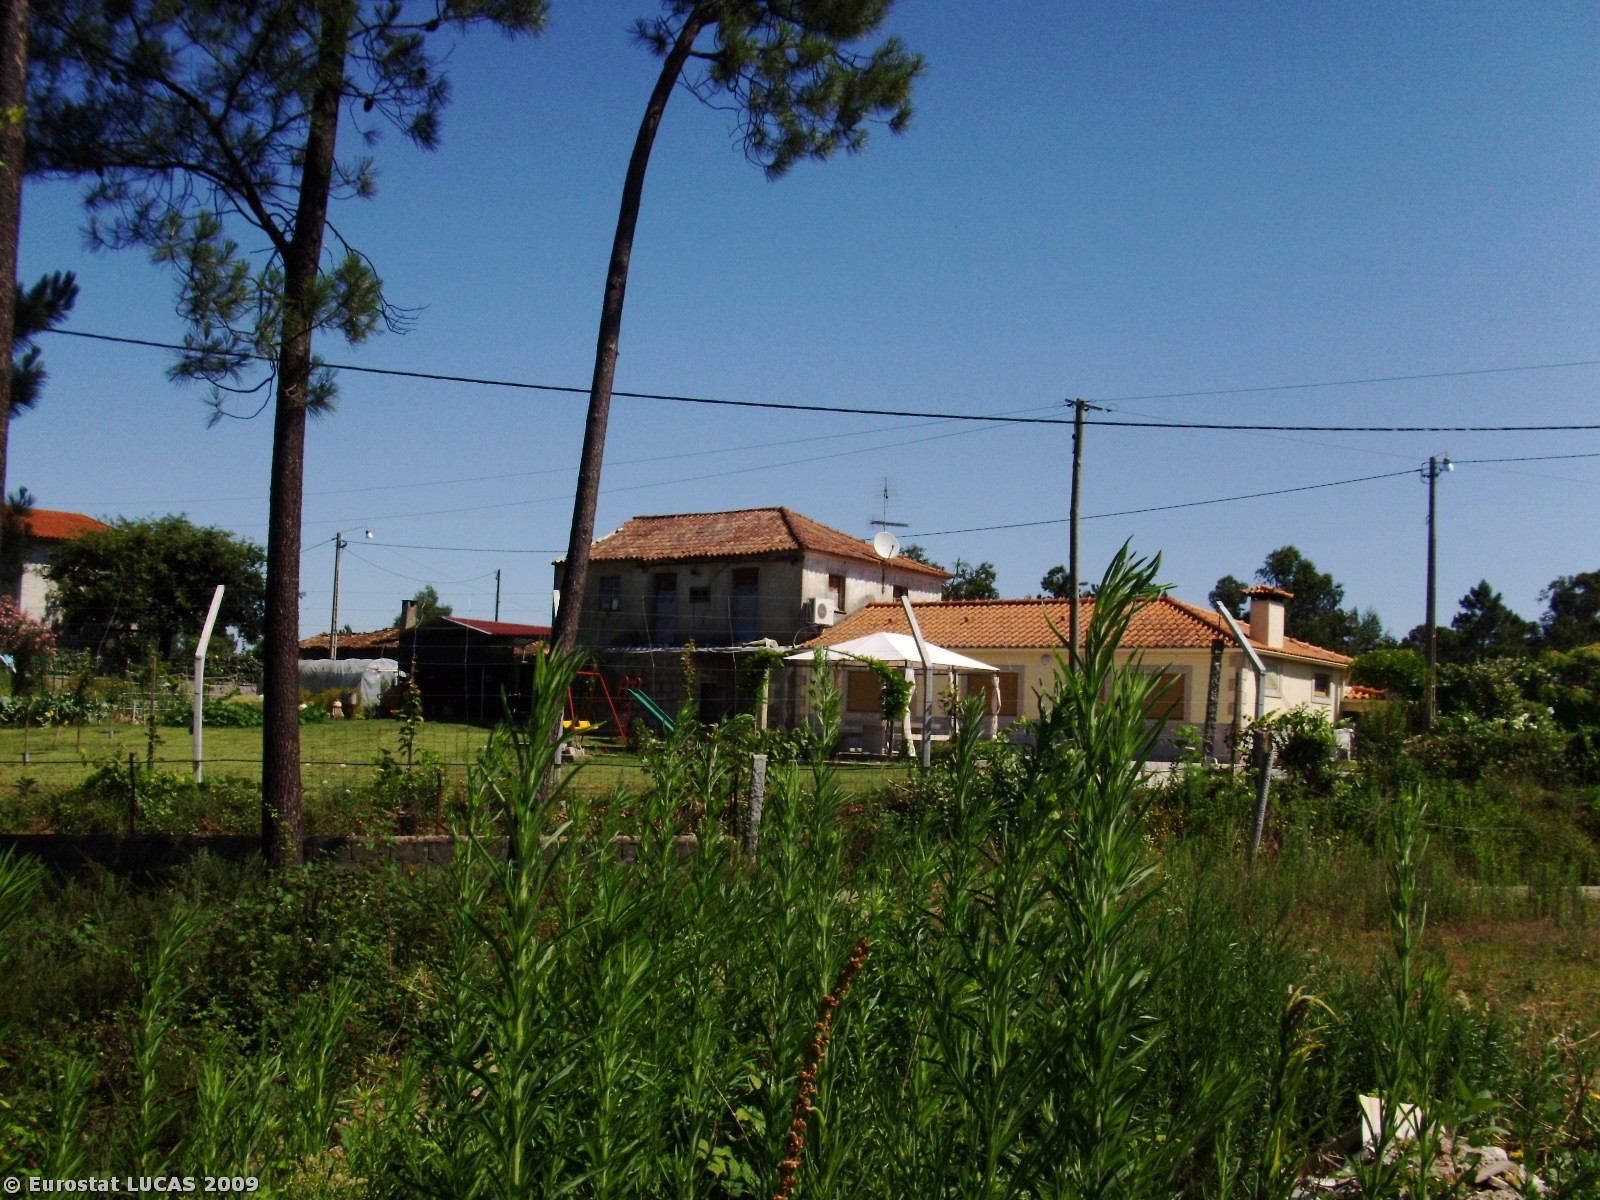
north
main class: Grassland
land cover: Spontaneously vegetated surfaces
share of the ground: 50 - 75 %
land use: Forestry
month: July
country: PT
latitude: 41.5579
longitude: -8.5135
